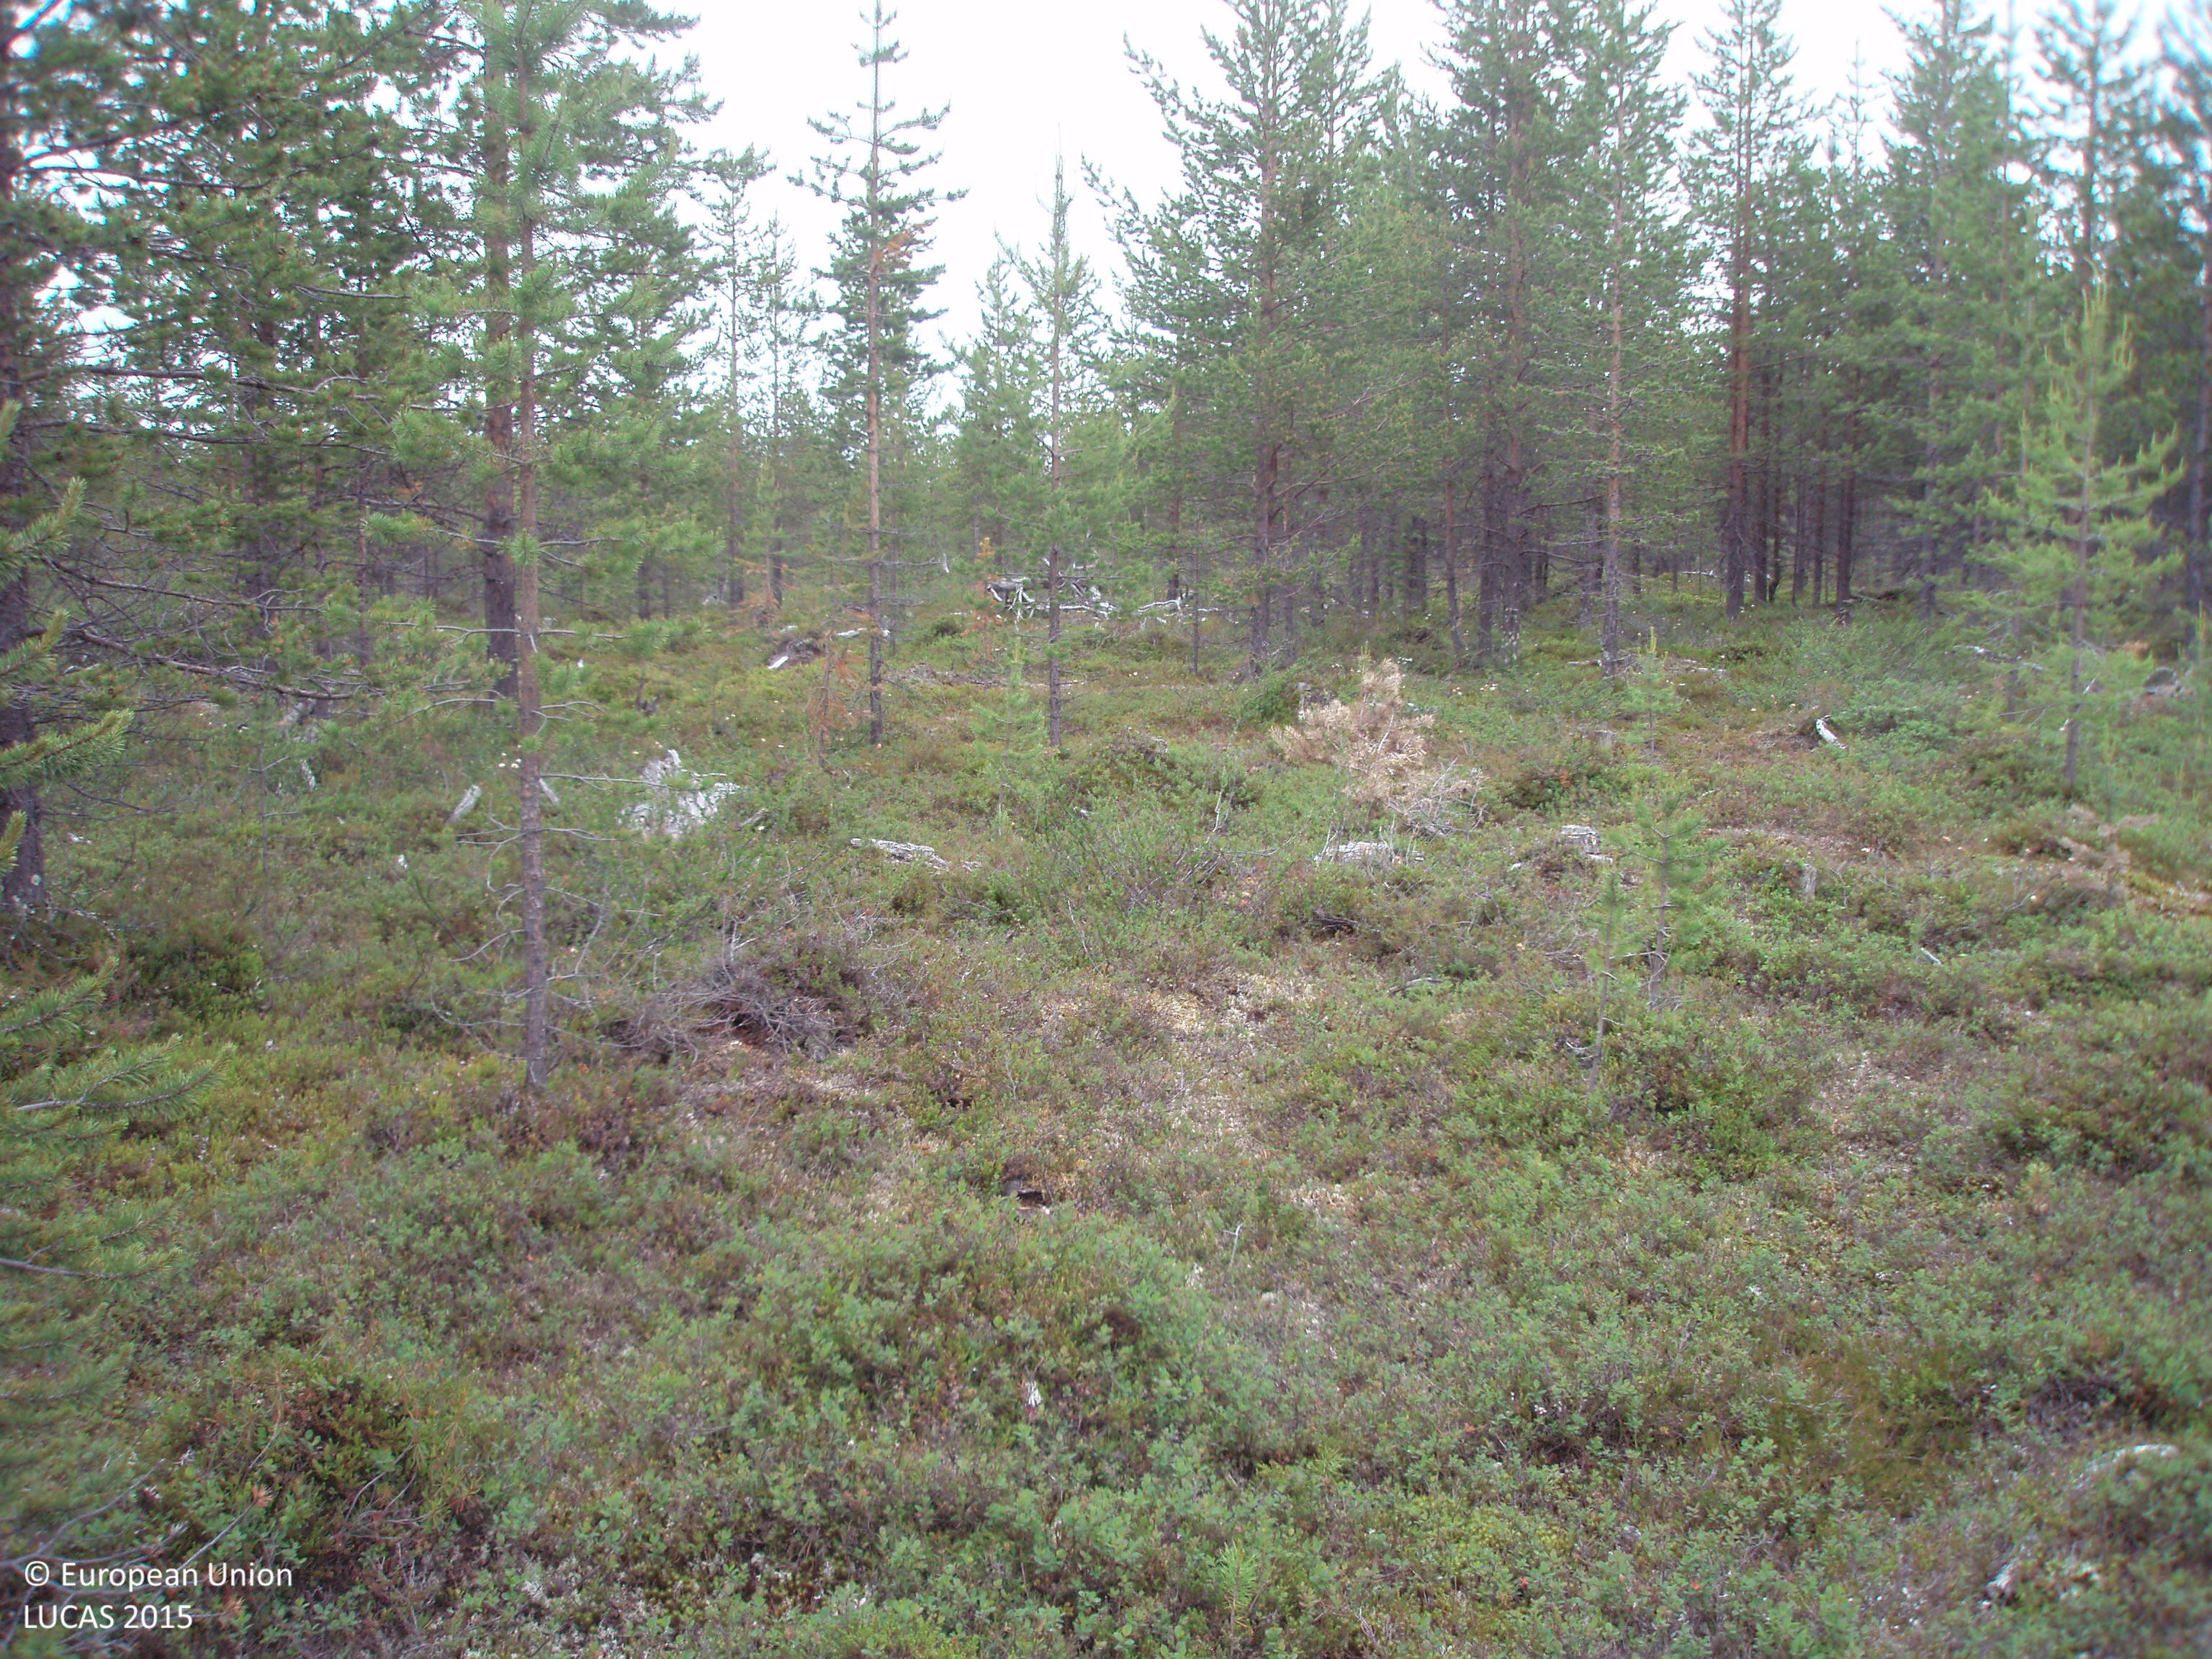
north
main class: Woodland
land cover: Pine dominated coniferous woodland
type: boreal forest
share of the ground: 25 - 50 %
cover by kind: shrubs 60 %, coniferous forest trees 35 %, lichens and mosses 5 %
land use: Forestry
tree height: < 5 m
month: July
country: FI
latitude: 67.7649
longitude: 29.0639
